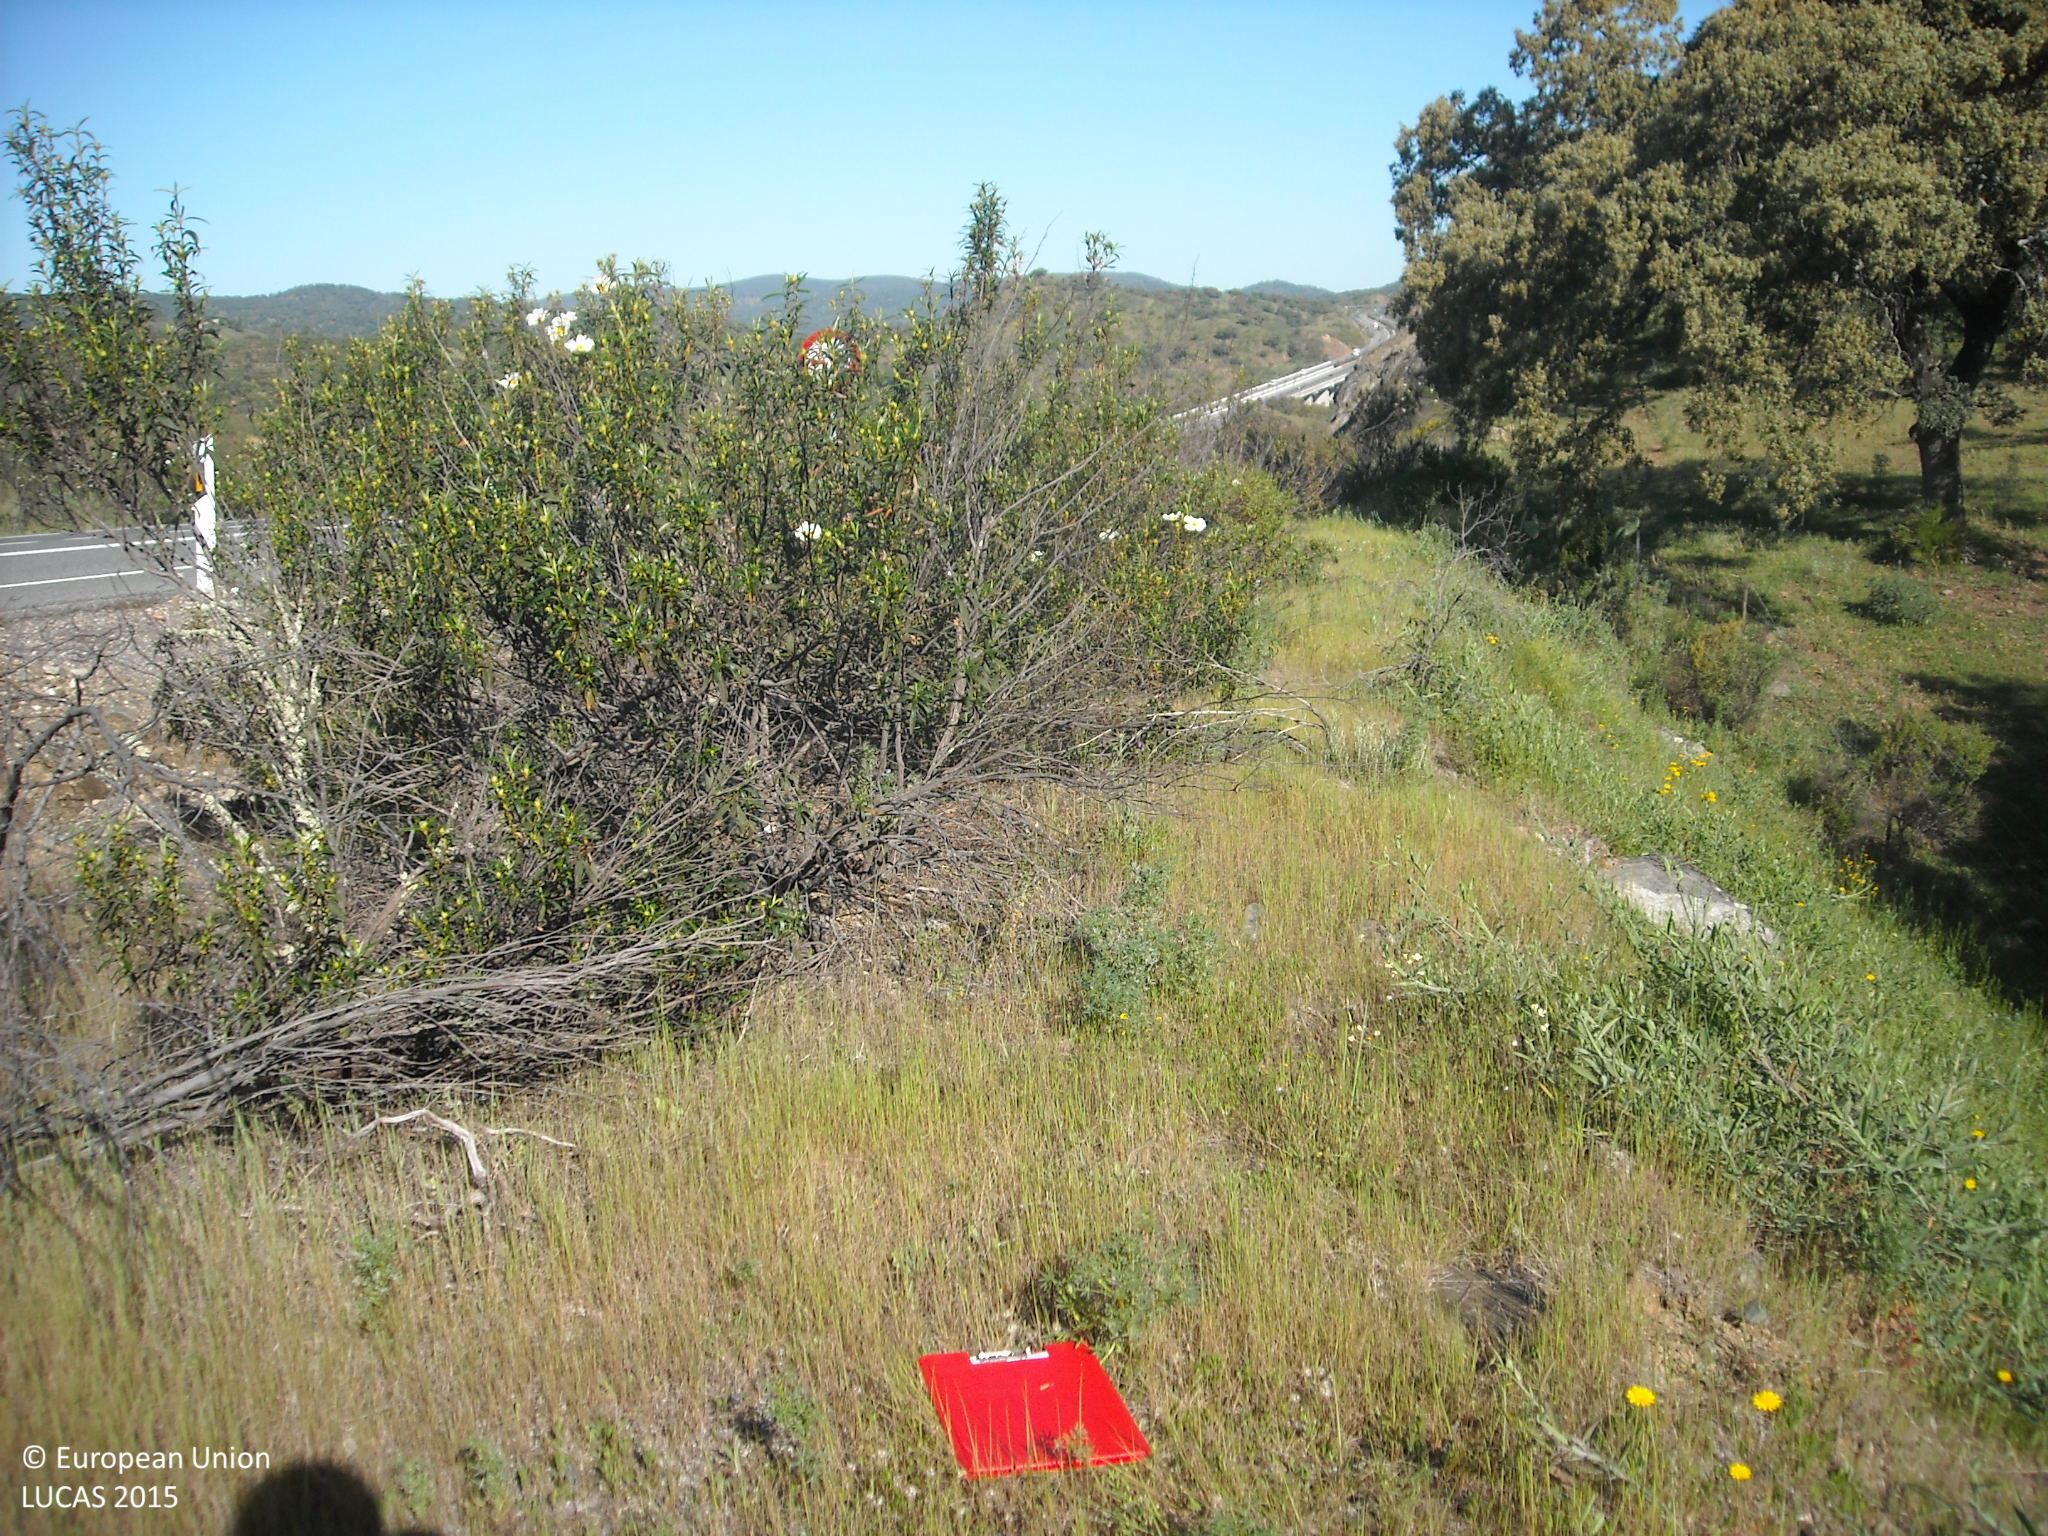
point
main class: Woodland
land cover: Broadleaved woodland
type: broadleaved evergreen forest
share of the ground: 10 - 25 %
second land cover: Grassland without tree/shrub cover
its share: > 75 %
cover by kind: herbaceous plants 75 %, broadleaved forest trees 25 %
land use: Forestry
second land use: Agriculture (excluding fallow land and kitchen gardens)
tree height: > 5 m
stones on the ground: < 10 %
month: April
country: ES
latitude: 37.6643
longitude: -6.1635
